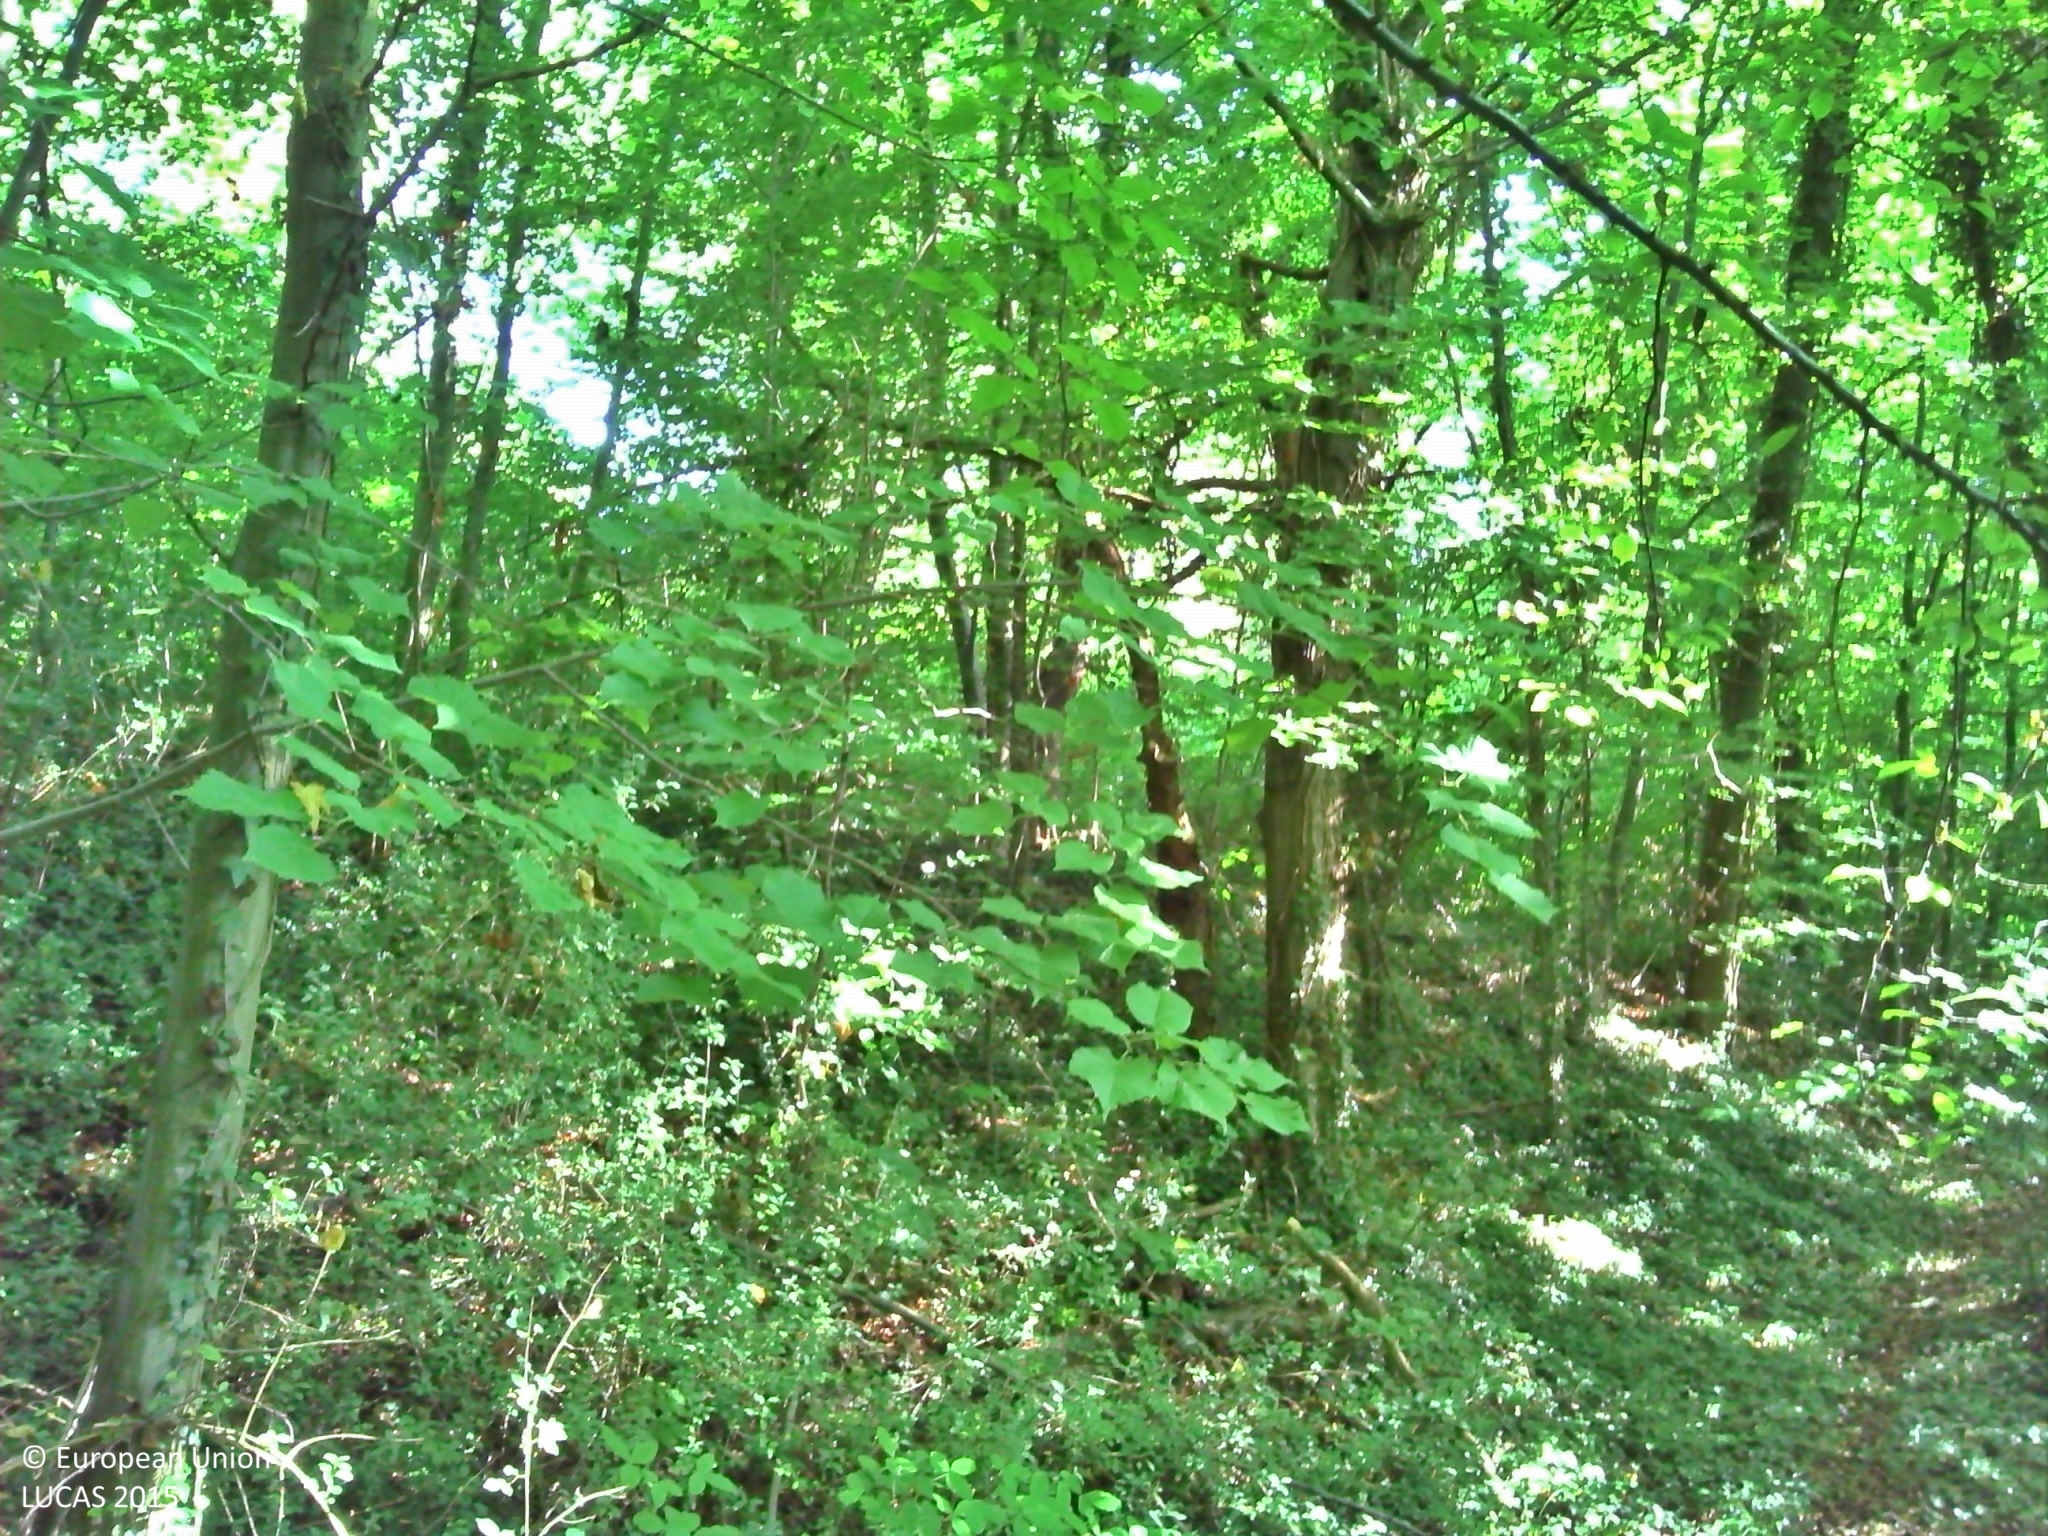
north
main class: Woodland
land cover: Broadleaved woodland
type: beech forest
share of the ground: > 75 %
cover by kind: broadleaved forest trees 70 %, shrubs 15 %, herbaceous plants 15 %
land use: Forestry
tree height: > 5 m
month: July
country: FR
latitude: 49.2951
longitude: 2.3559
